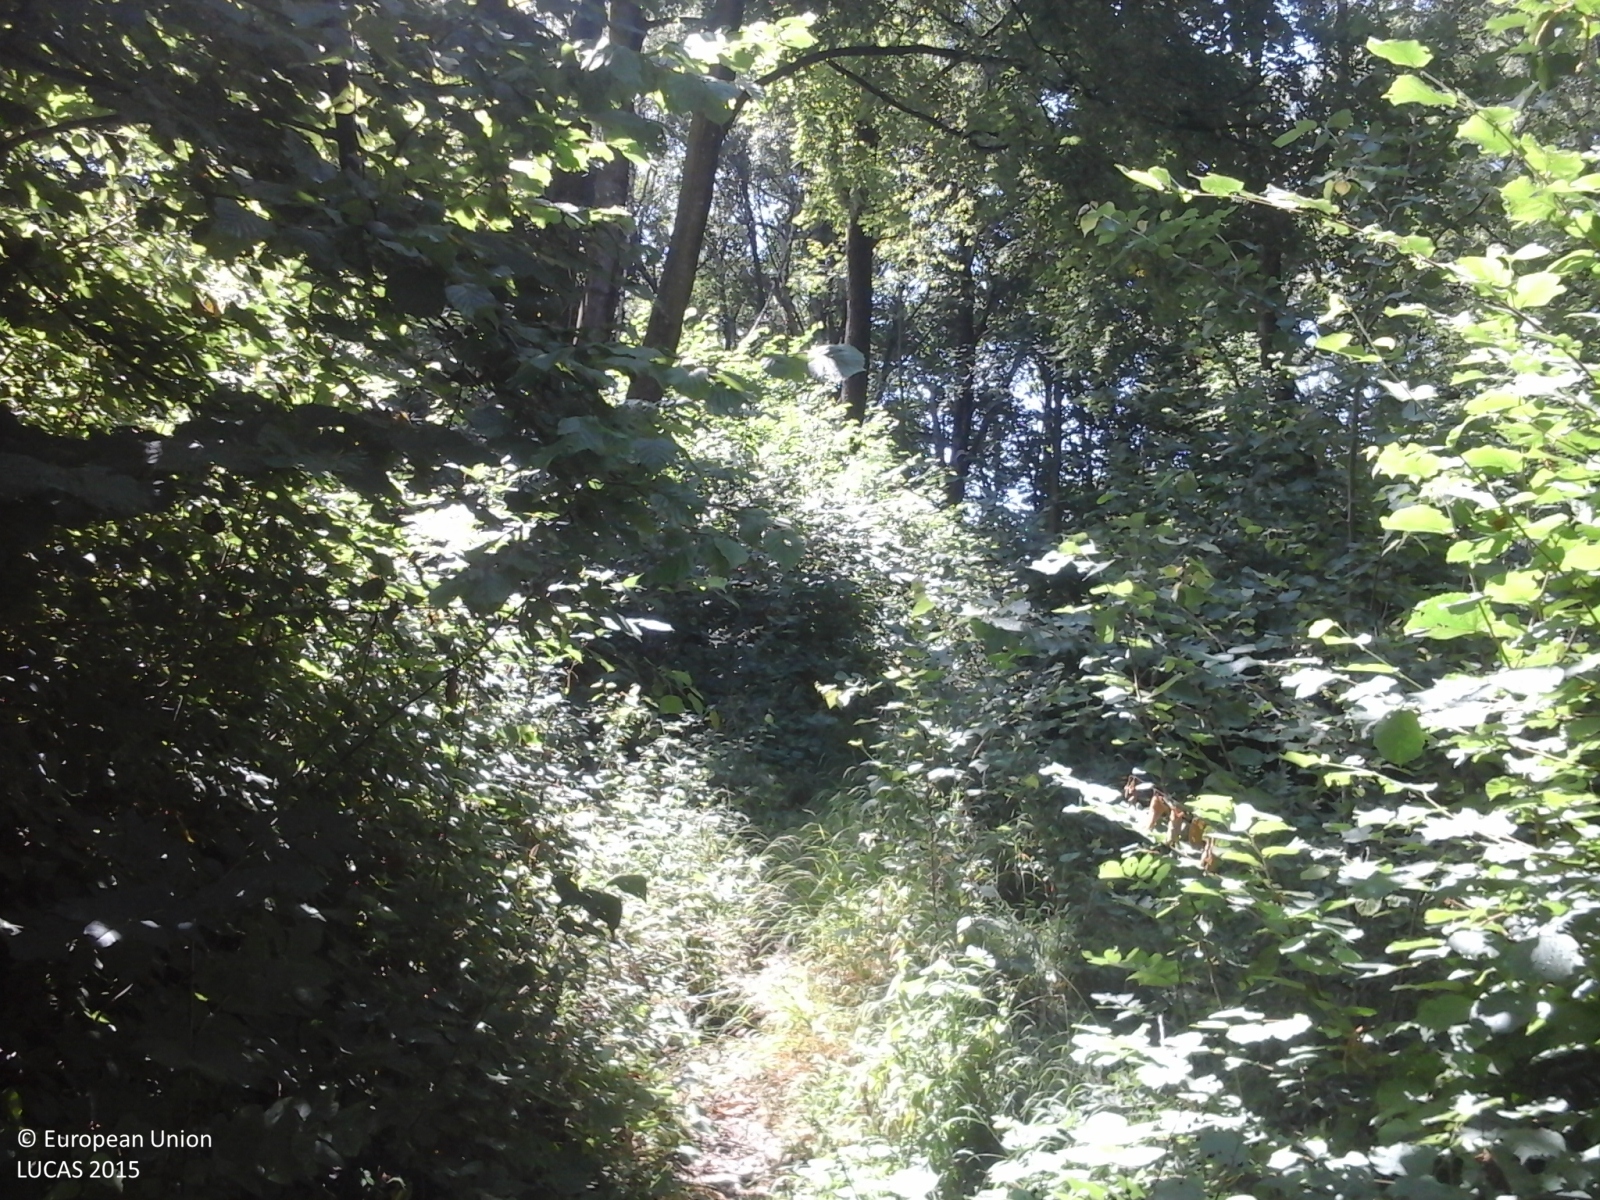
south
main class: Woodland
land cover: Broadleaved woodland
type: mesophytic deciduous forest
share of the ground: > 75 %
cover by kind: broadleaved forest trees 100 %
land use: Forestry
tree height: > 5 m
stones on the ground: 10 - 25 %
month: August
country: IT
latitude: 45.8990
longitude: 9.3694
